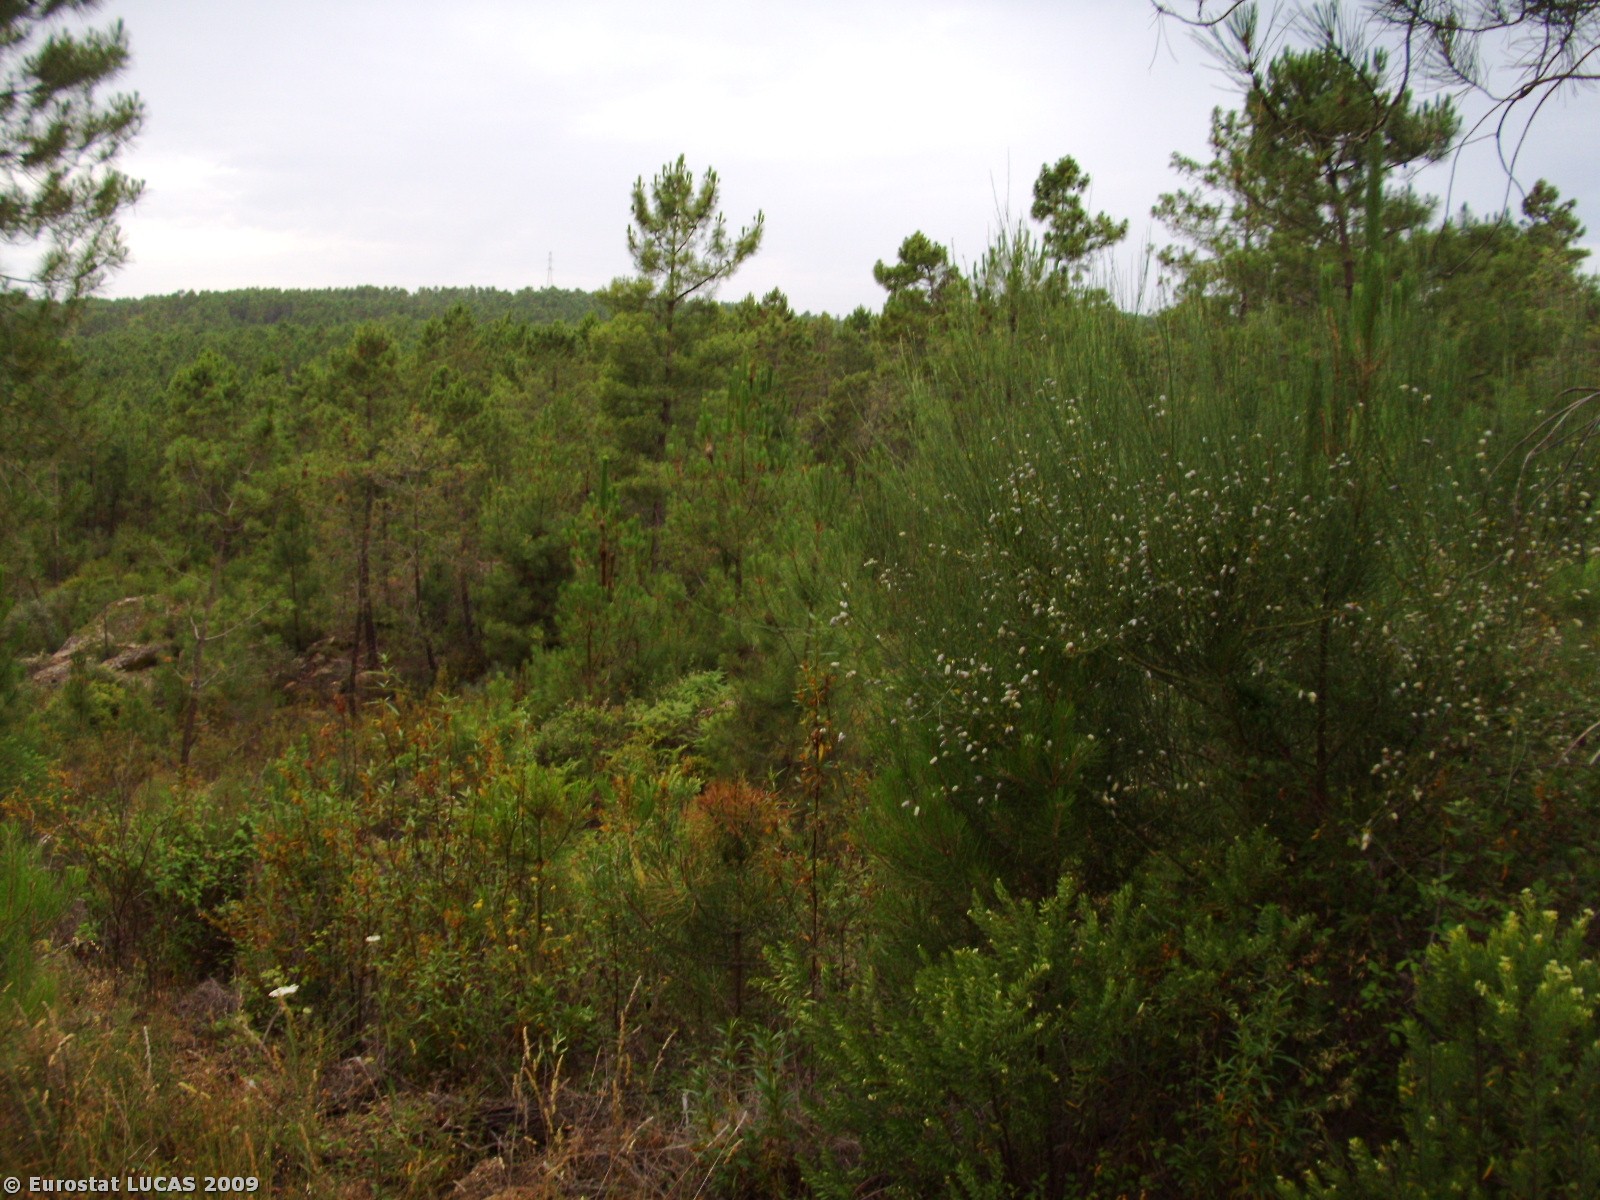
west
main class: Woodland
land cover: Coniferous woodland
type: coniferous forest of the mediterranean region
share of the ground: > 75 %
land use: Forestry
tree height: > 5 m
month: June
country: PT
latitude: 39.9312
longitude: -7.5253
